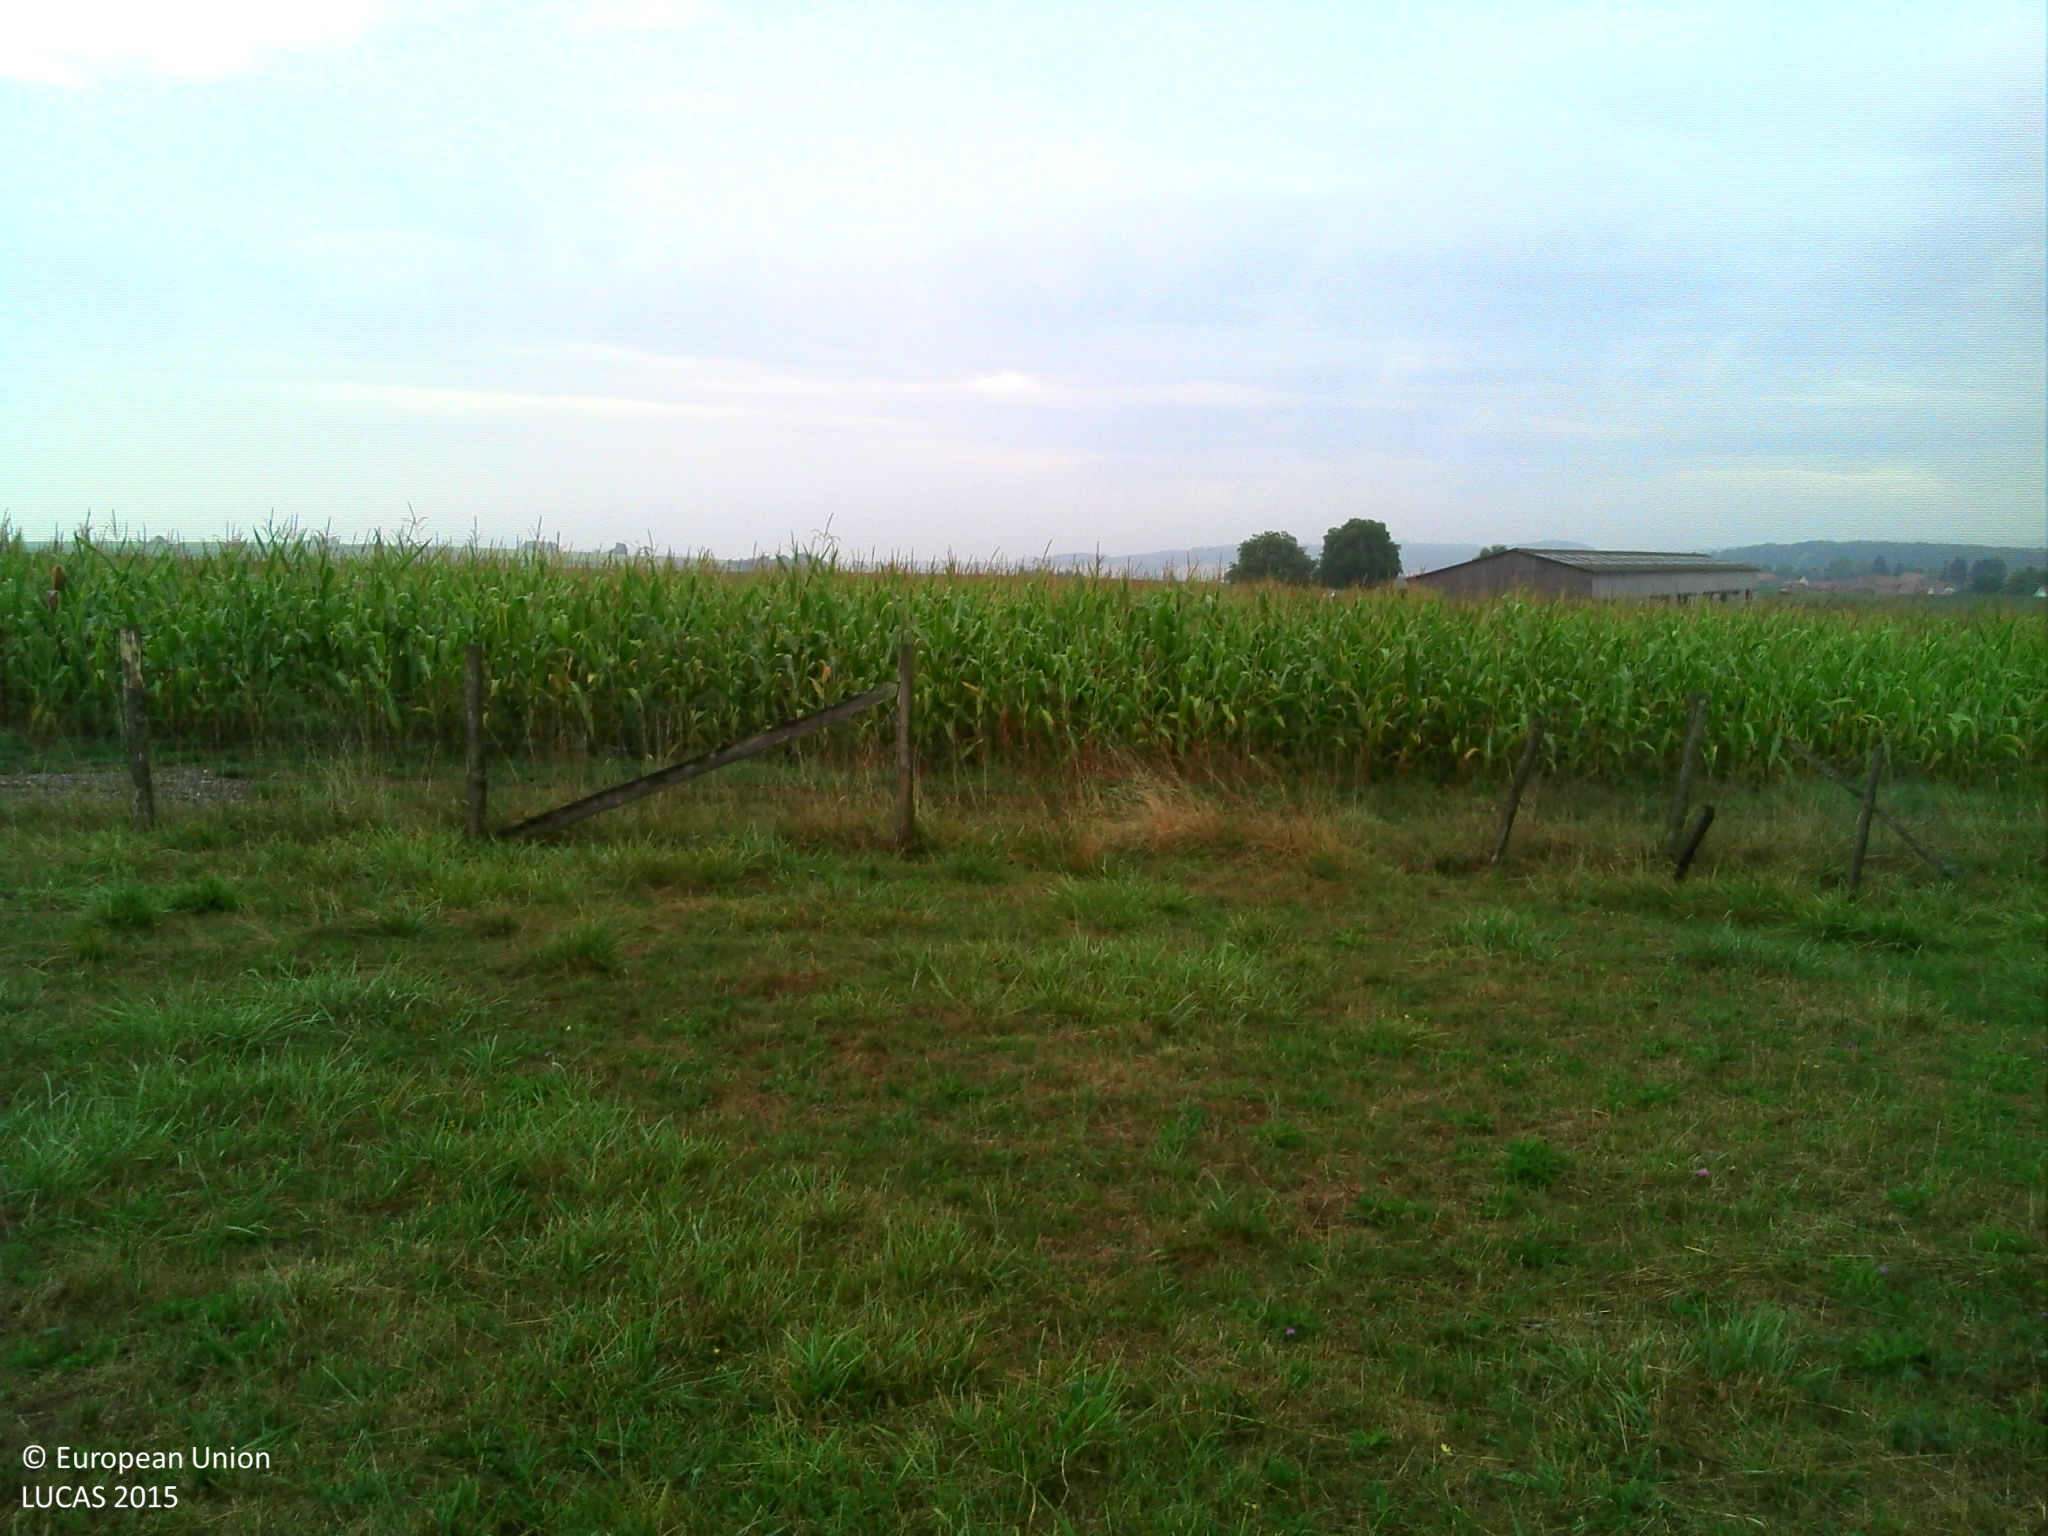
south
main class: Grassland
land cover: Grassland with sparse tree/shrub cover
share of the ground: > 75 %
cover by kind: herbaceous plants 95 %, broadleaved forest trees 5 %
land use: Agriculture (excluding fallow land and kitchen gardens)
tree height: > 5 m
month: August
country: FR
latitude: 48.8800
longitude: 7.5325
